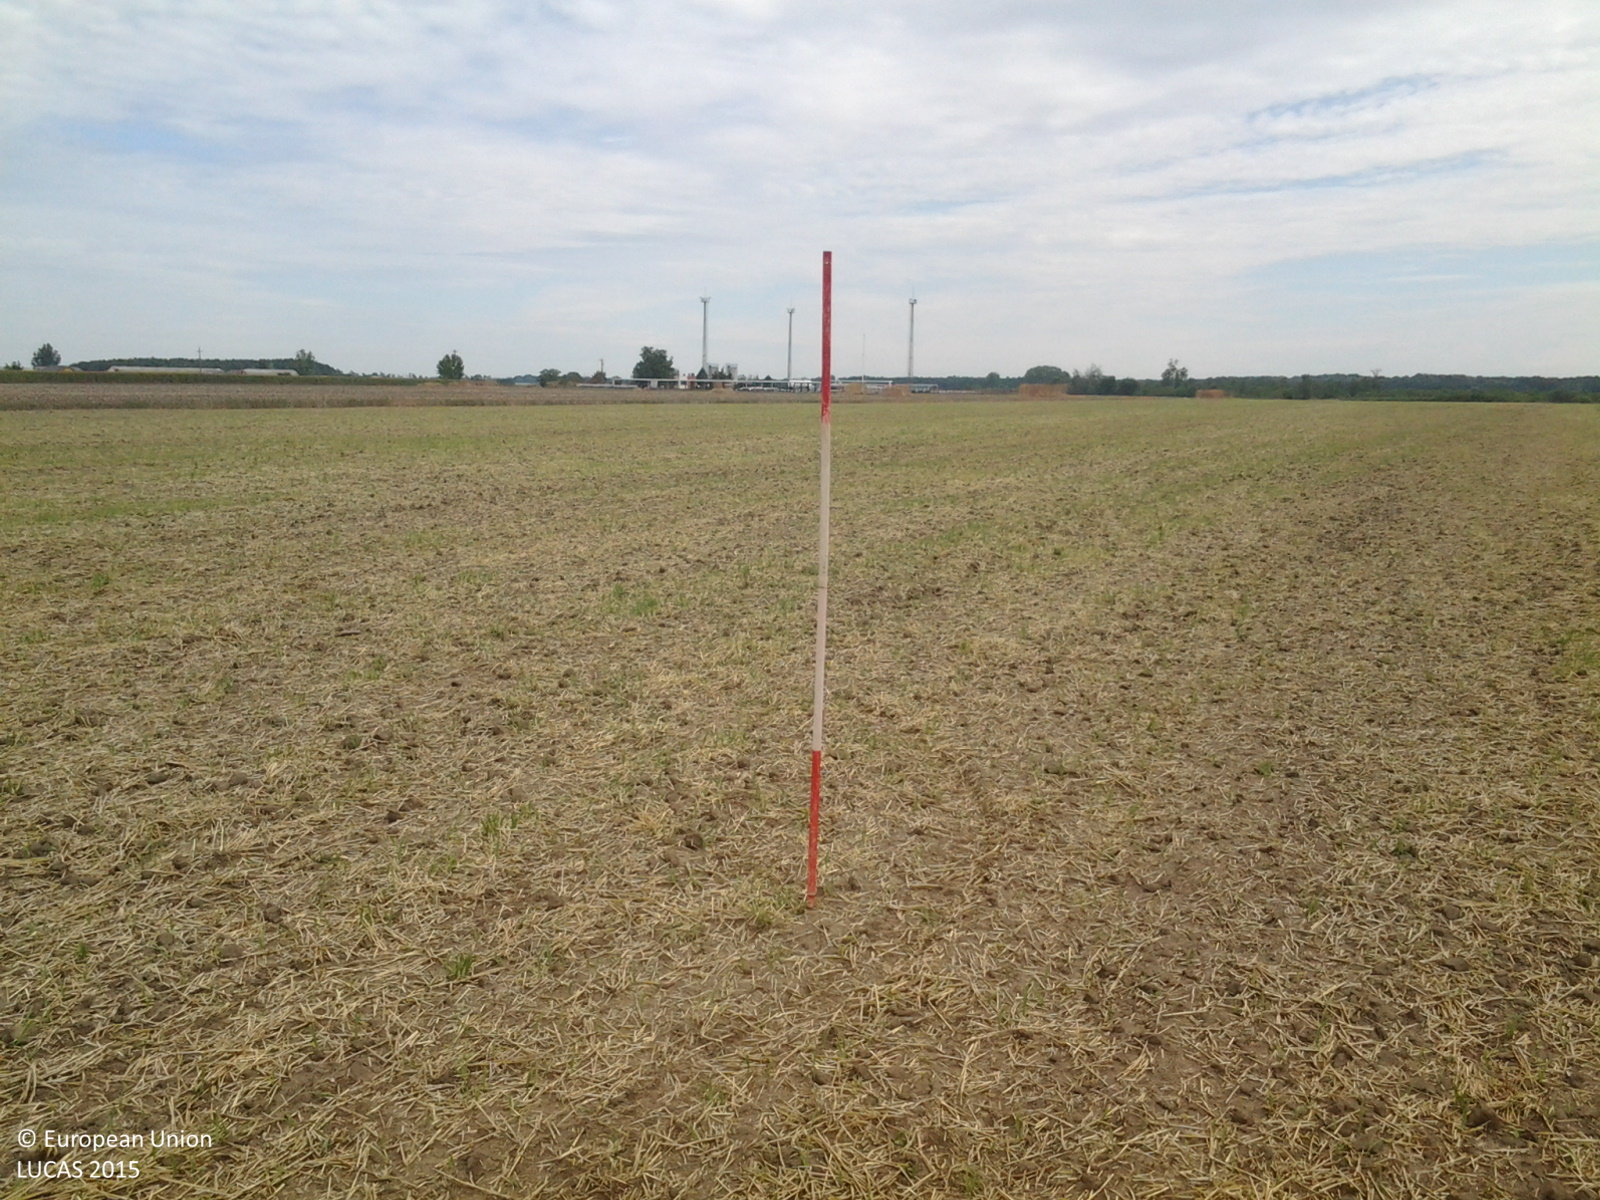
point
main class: Cropland
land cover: Common wheat
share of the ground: < 10 %
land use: Agriculture (excluding fallow land and kitchen gardens)
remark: Harvested field
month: July
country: HU
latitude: 47.1006
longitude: 21.2504
